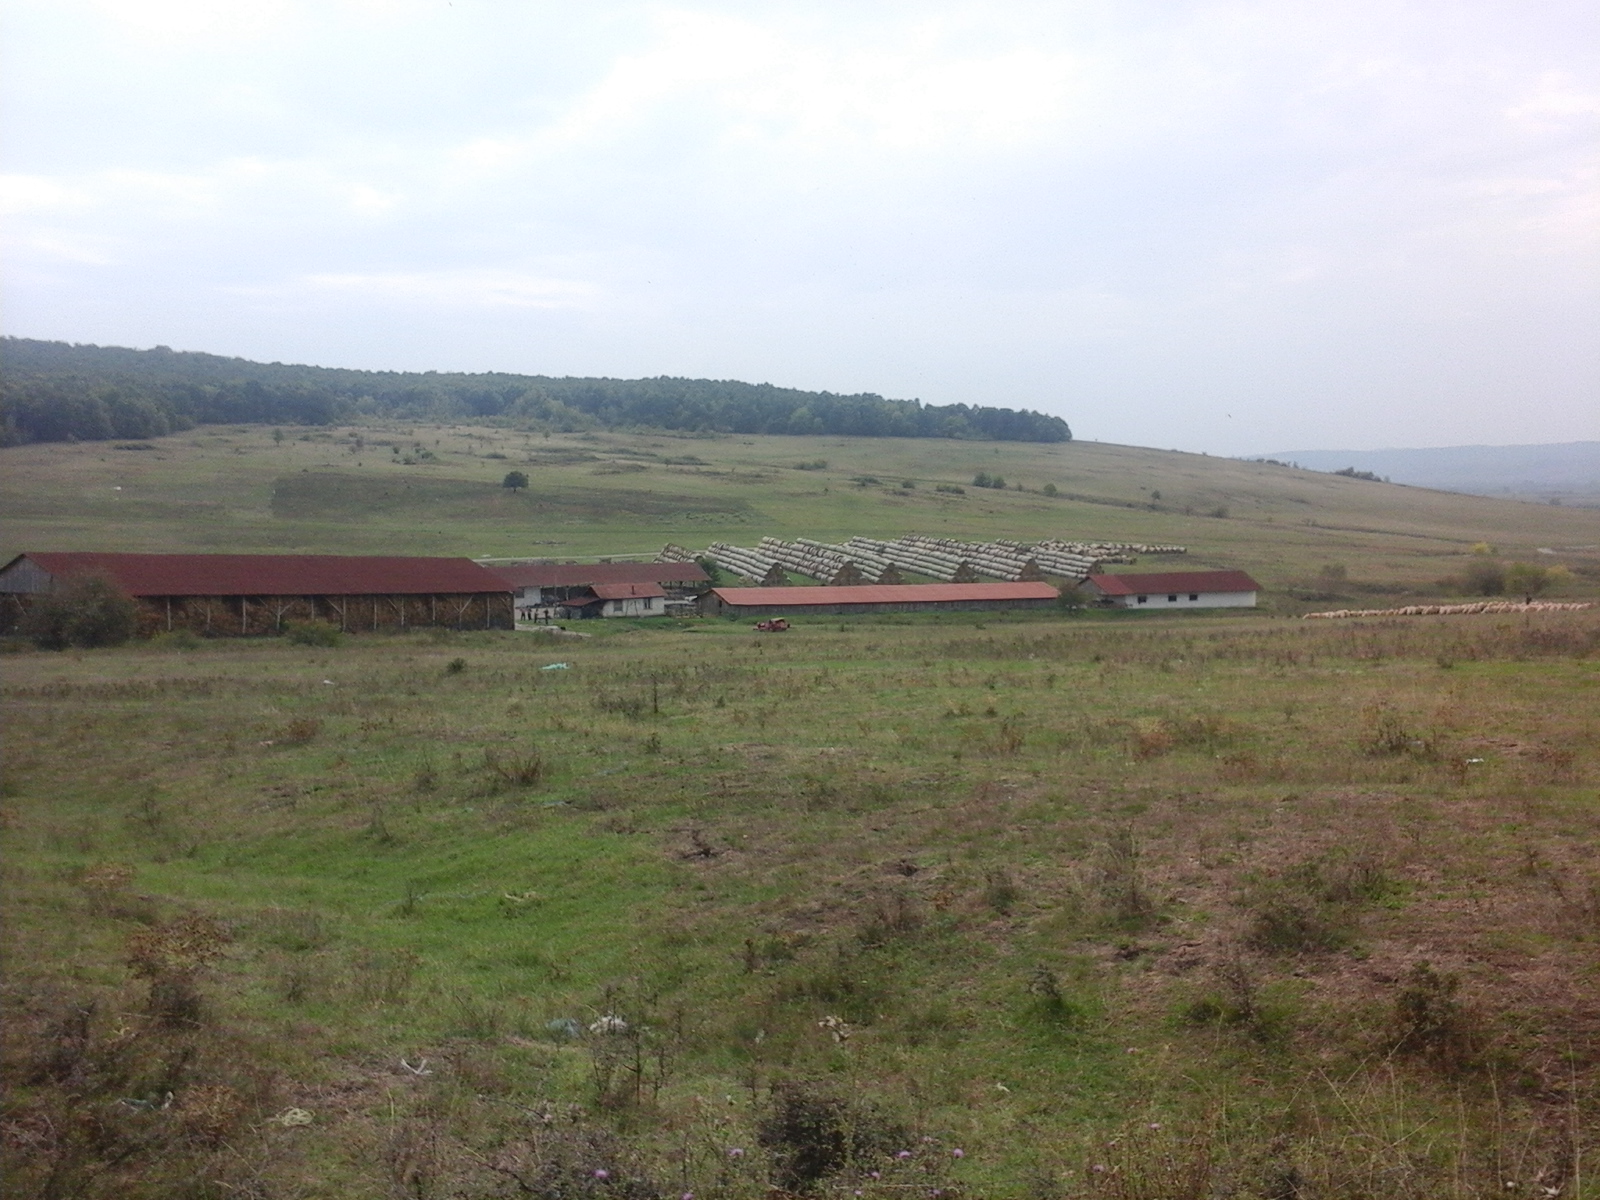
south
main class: Grassland
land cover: Spontaneously vegetated surfaces
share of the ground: > 75 %
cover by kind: herbaceous plants 100 %
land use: Agriculture (excluding fallow land and kitchen gardens)
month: September
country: RO
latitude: 45.7305
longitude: 23.0467
